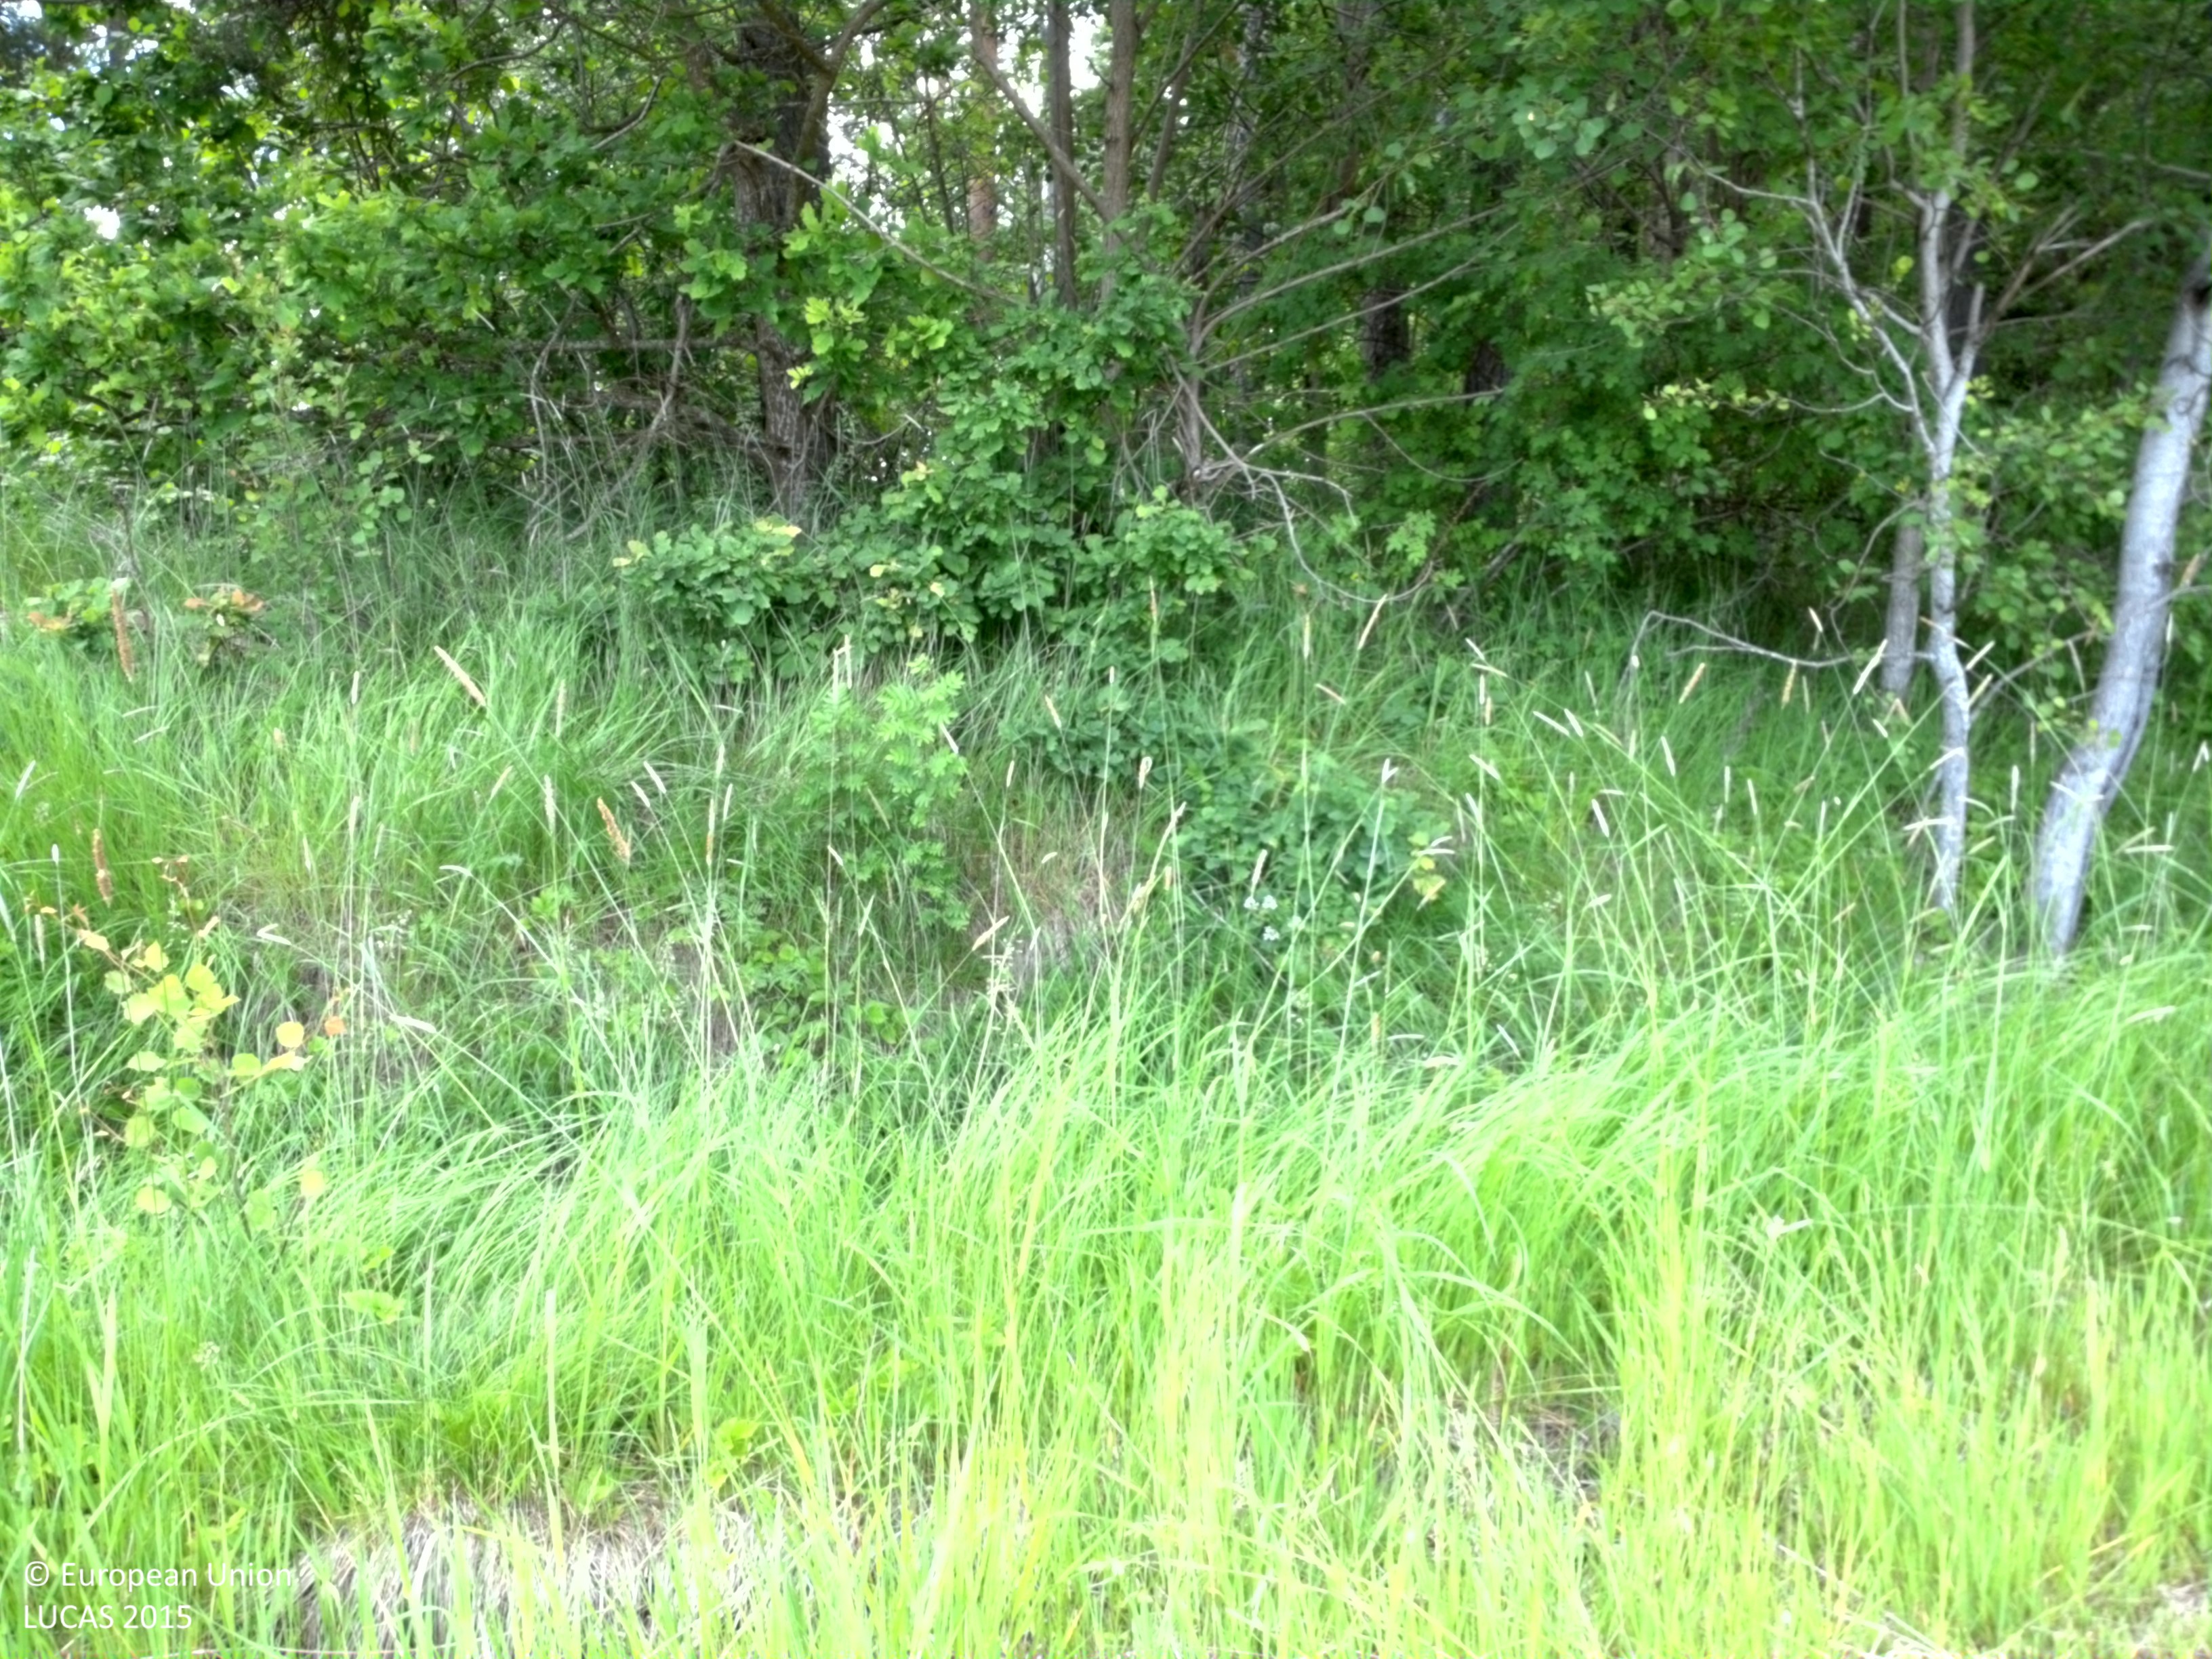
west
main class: Cropland
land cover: Temporary grasslands
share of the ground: > 75 %
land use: Agriculture (excluding fallow land and kitchen gardens)
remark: Harvested field
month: June
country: SE
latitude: 58.4468
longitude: 16.3867
